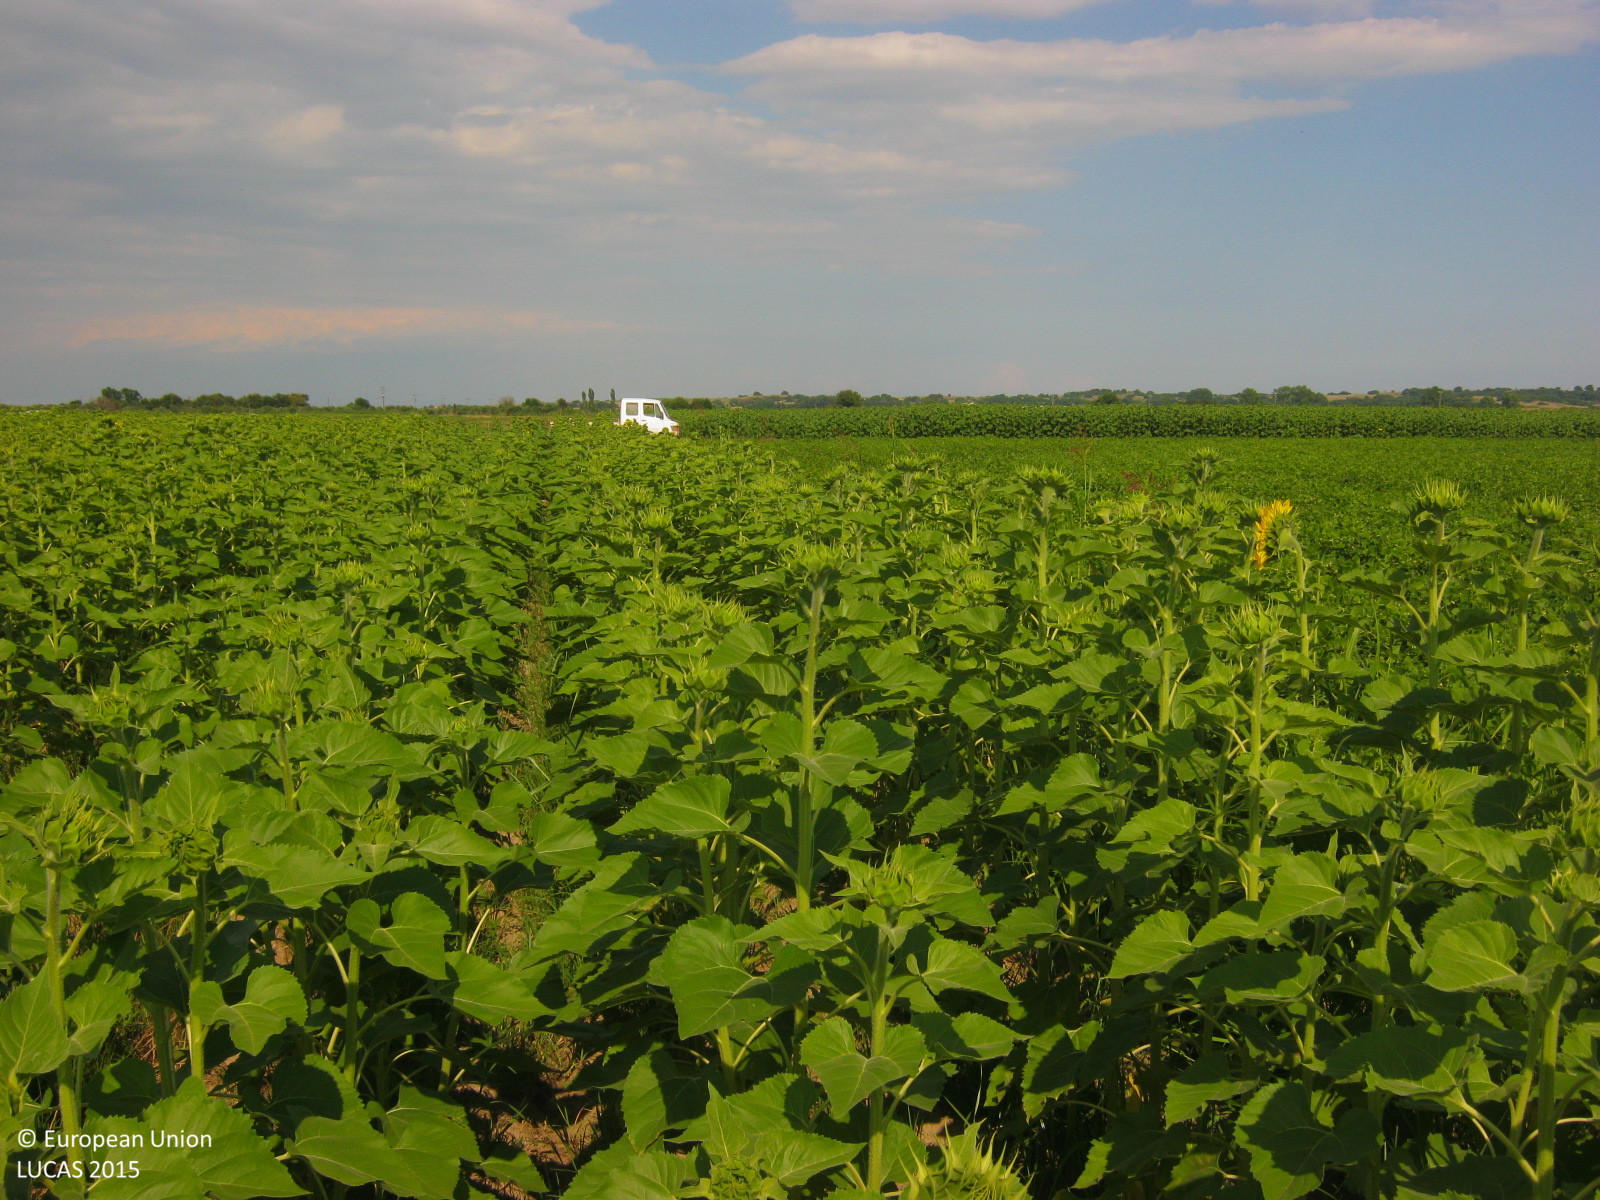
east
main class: Cropland
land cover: Sunflower
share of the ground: > 75 %
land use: Agriculture (excluding fallow land and kitchen gardens)
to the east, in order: Sunflower; Grass margins; Tracks; Grass margins; Sunflower; Grass margins; Common wheat
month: June
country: GR
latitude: 40.9505
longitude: 24.9489
